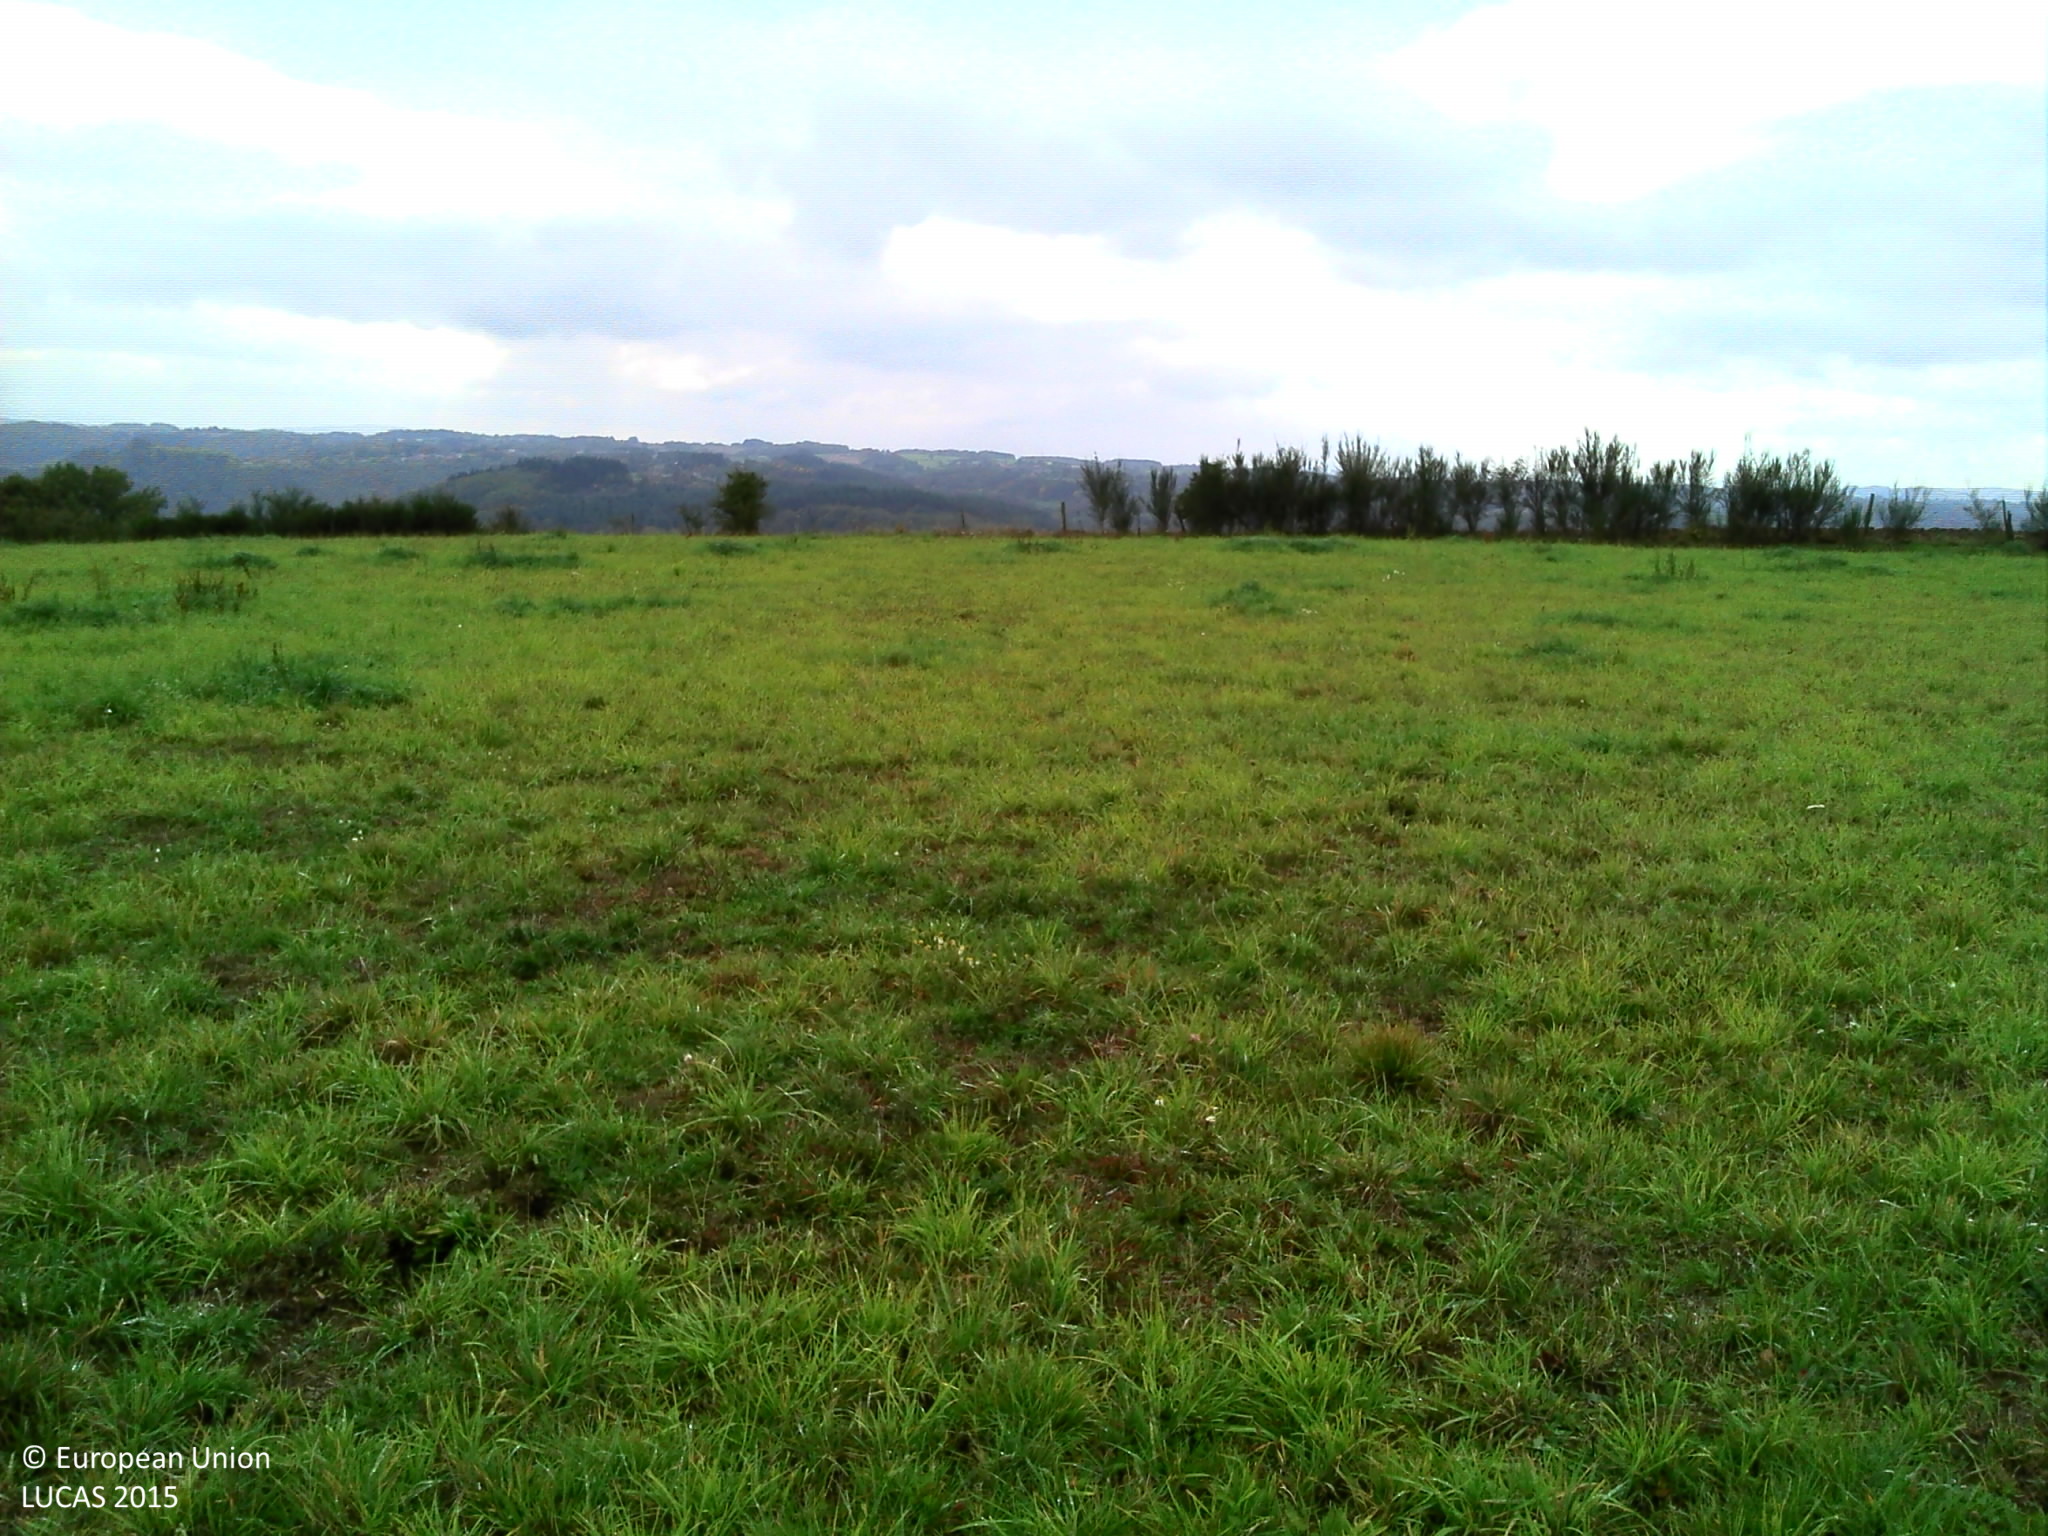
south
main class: Grassland
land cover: Grassland without tree/shrub cover
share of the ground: > 75 %
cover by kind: herbaceous plants 95 %, unconsolidated bare surface 5 %
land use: Agriculture (excluding fallow land and kitchen gardens)
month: October
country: FR
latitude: 46.0020
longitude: 2.8314
